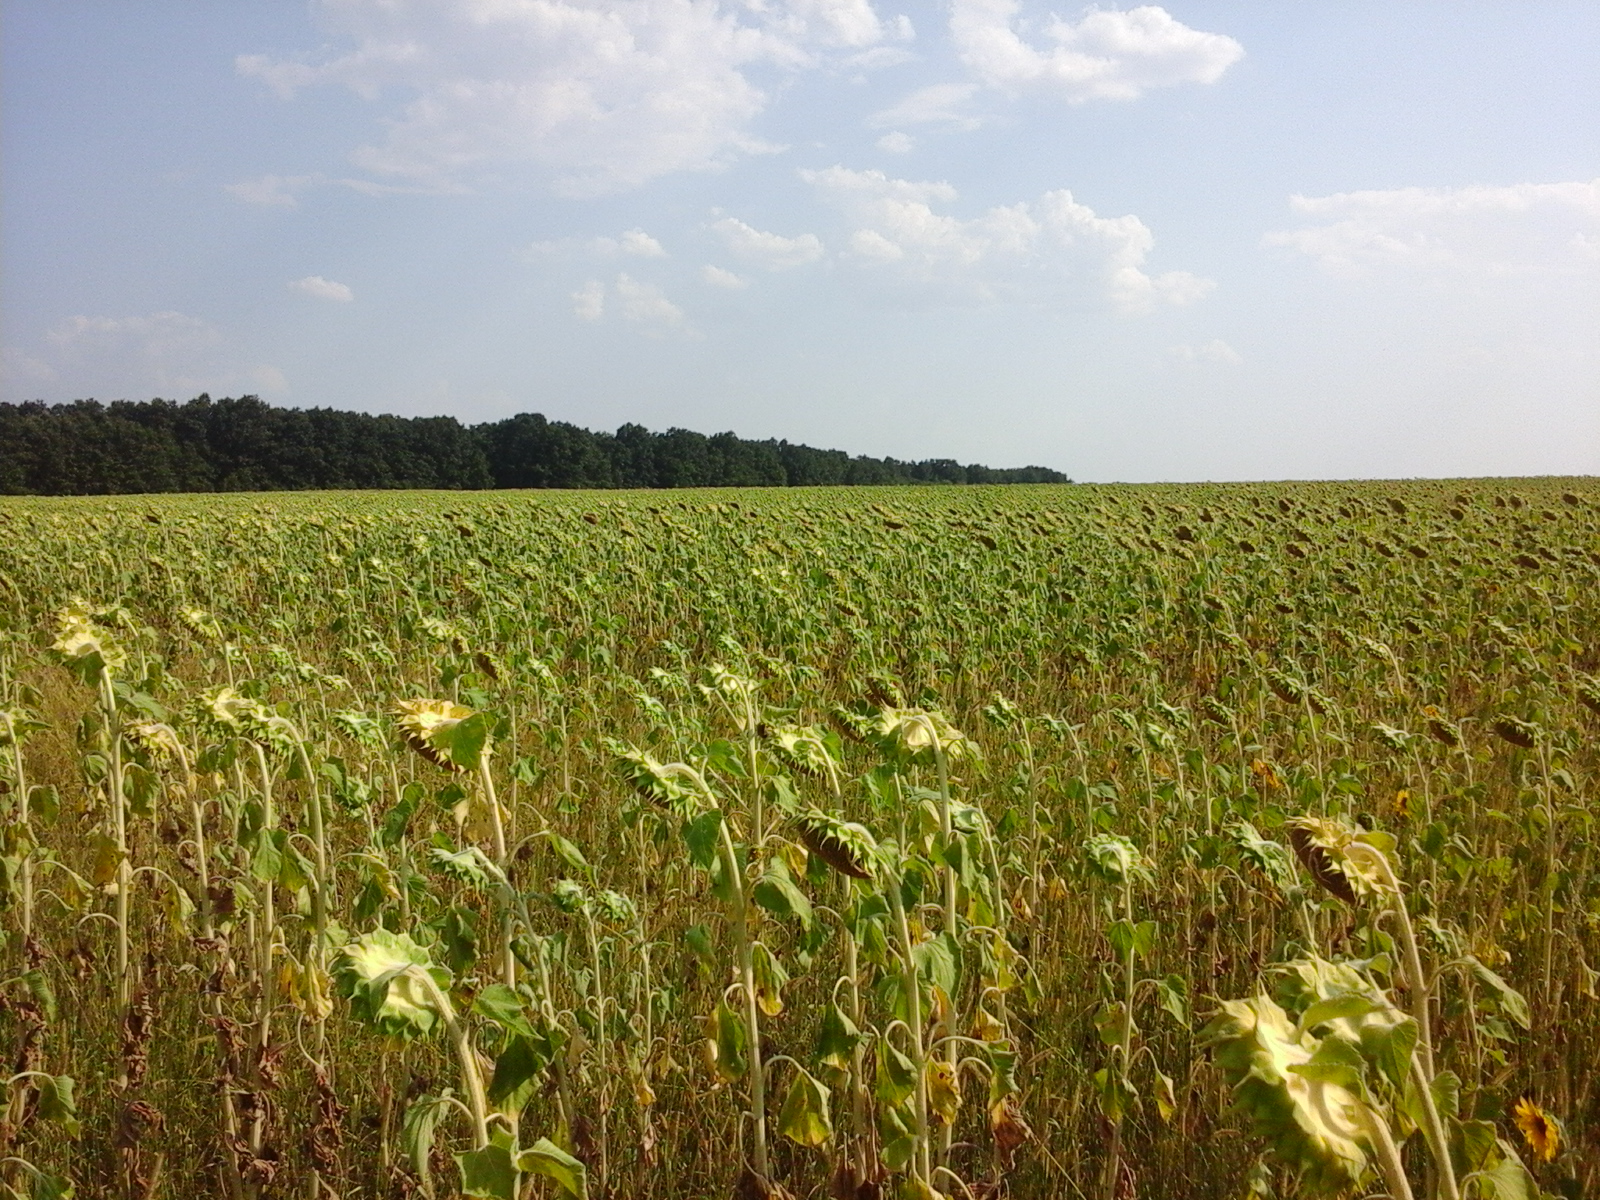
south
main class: Cropland
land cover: Sunflower
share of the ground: > 75 %
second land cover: Spontaneously vegetated surfaces
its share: 50 - 75 %
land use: Fallow land
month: August
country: RO
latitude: 44.1957
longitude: 23.6285
